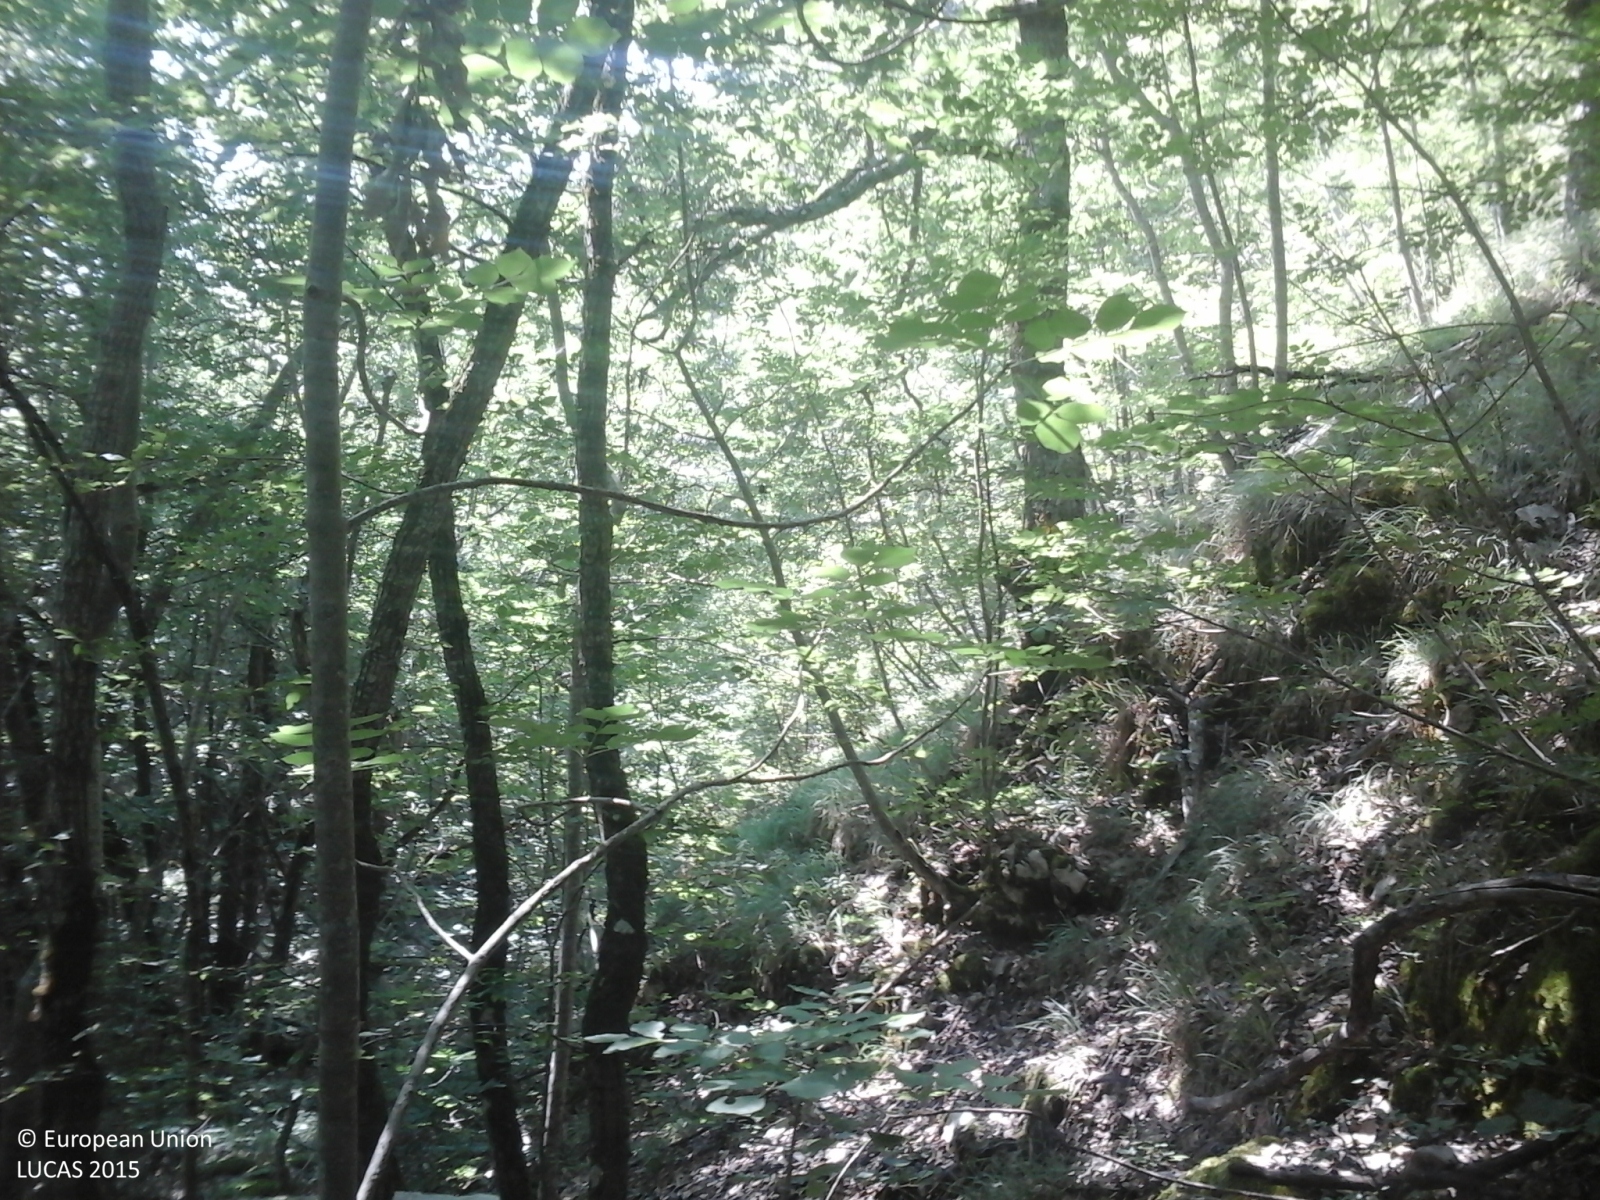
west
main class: Woodland
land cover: Broadleaved woodland
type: thermophilous deciduous forest
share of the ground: > 75 %
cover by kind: broadleaved forest trees 100 %
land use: Forestry
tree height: > 5 m
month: August
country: IT
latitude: 42.9472
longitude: 13.1898
